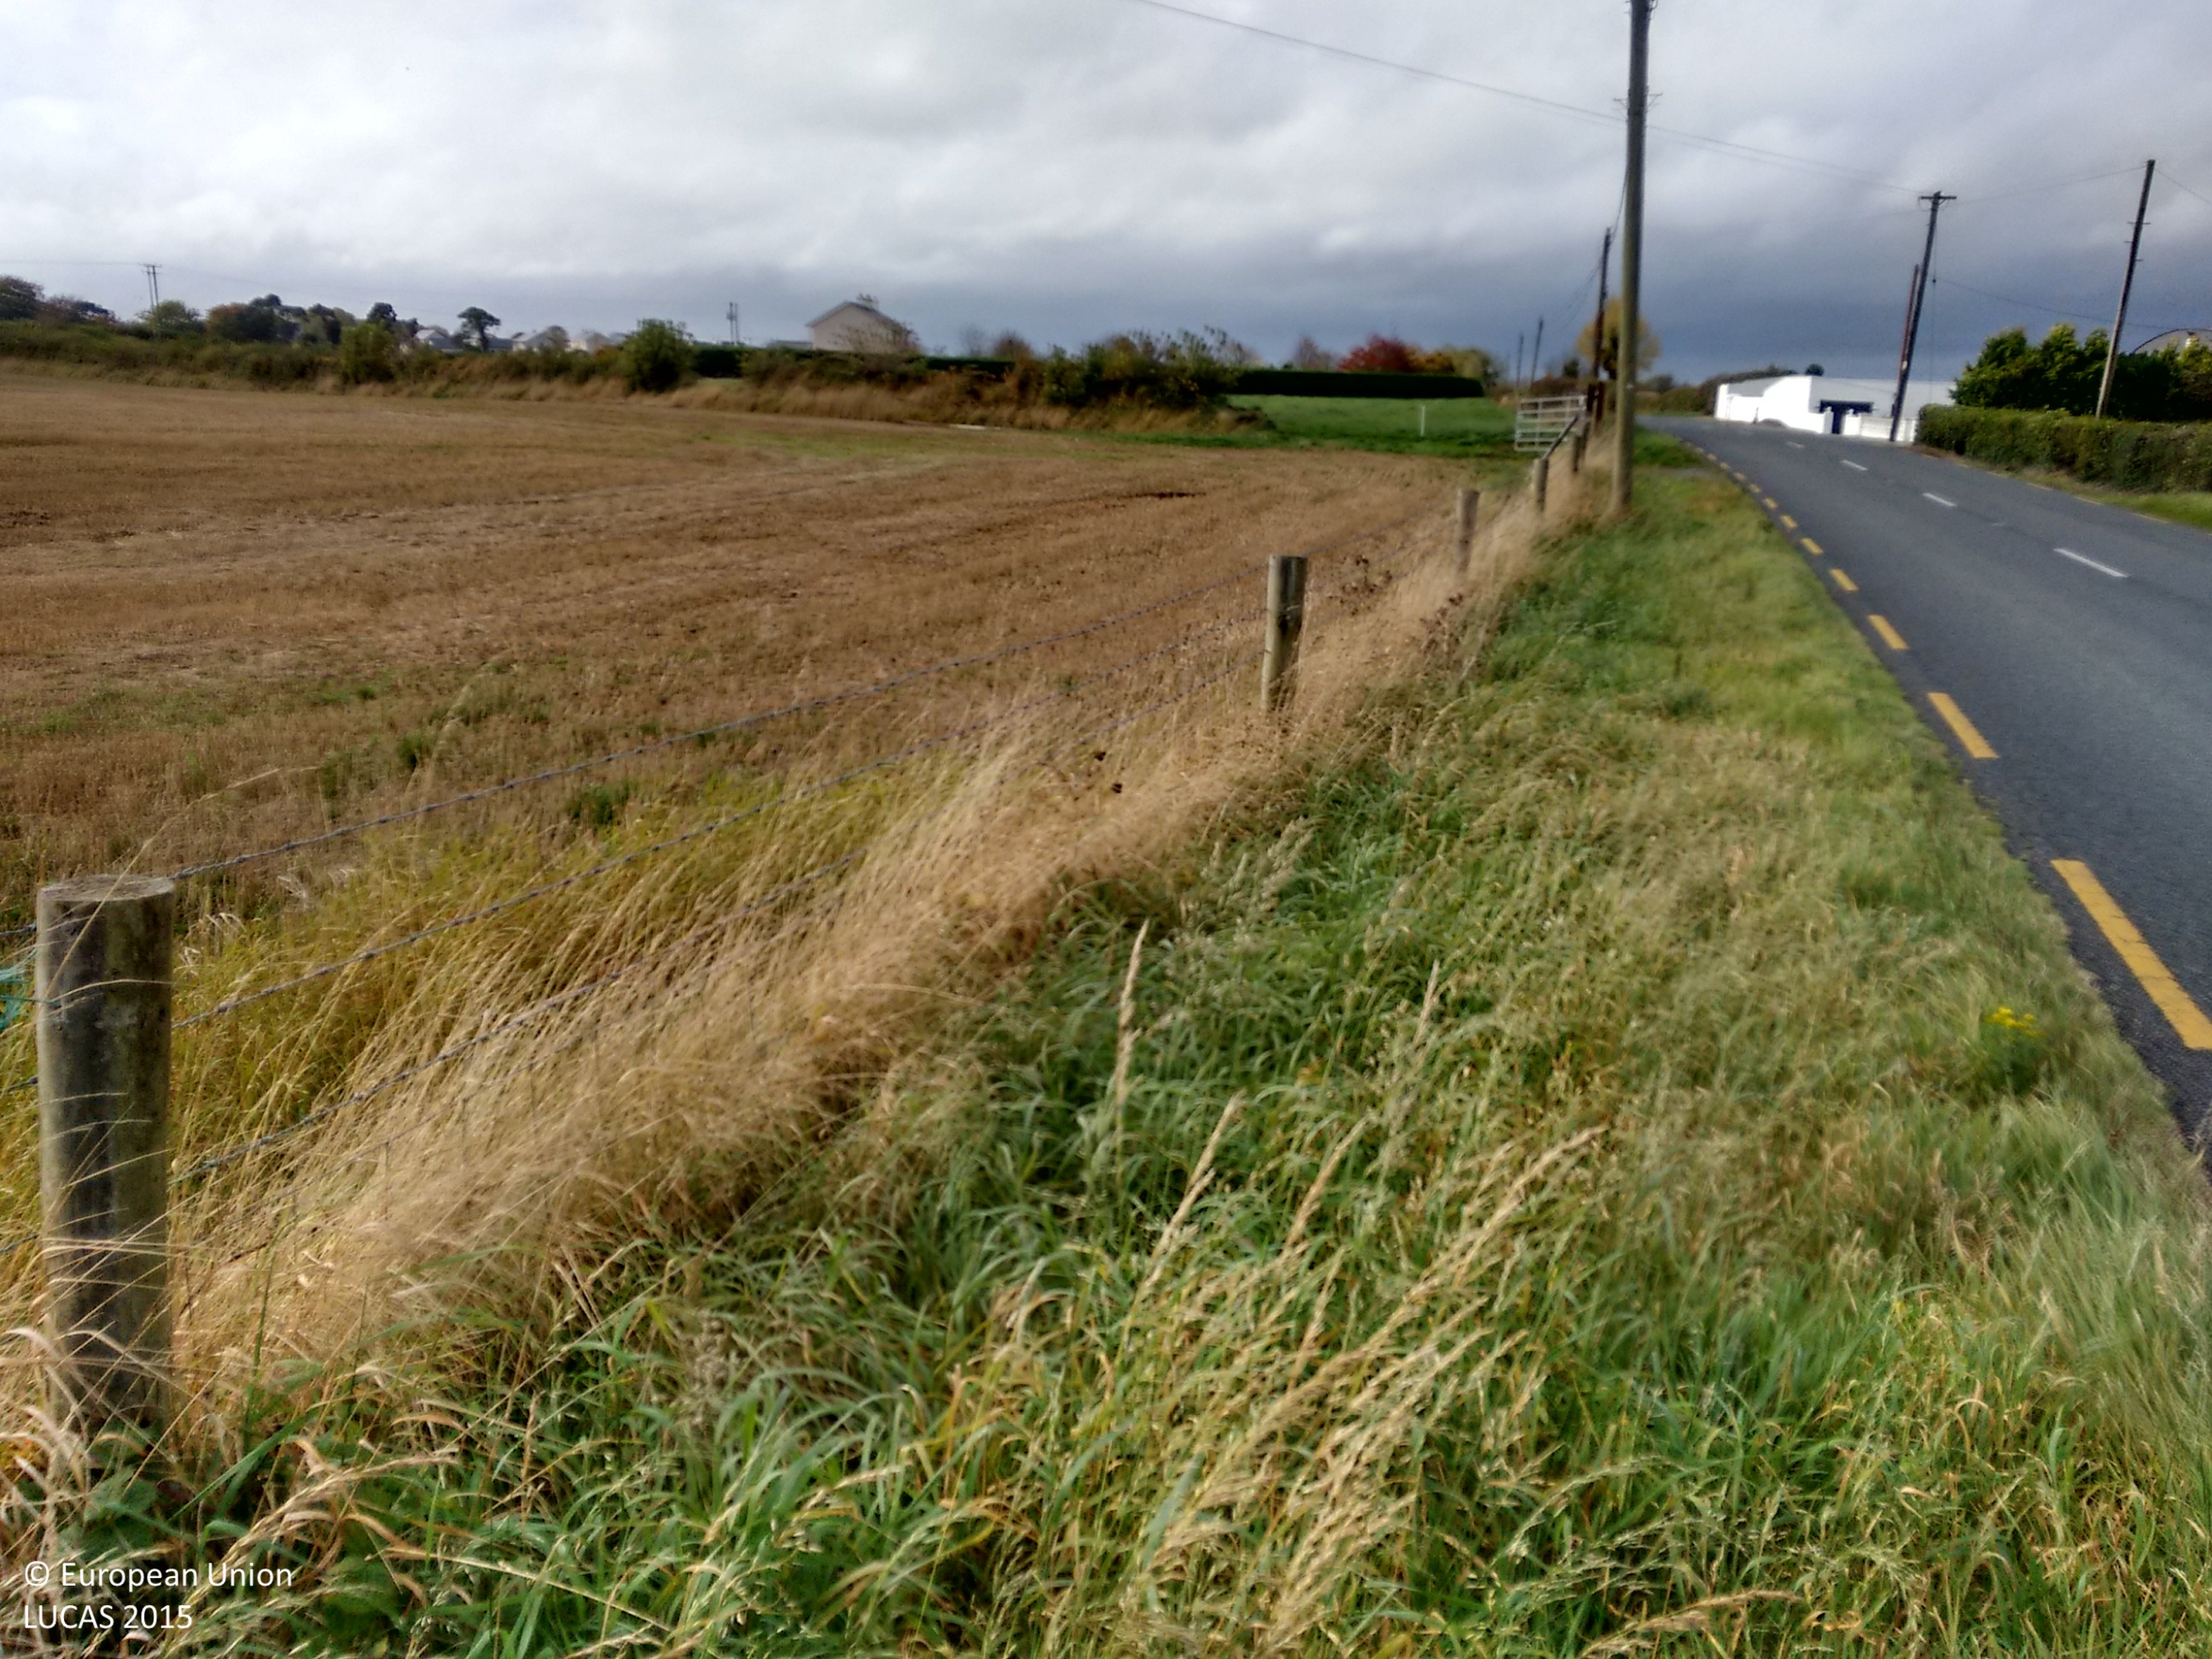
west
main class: Grassland
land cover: Grassland without tree/shrub cover
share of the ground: > 75 %
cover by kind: herbaceous plants 95 %, shrubs 5 %
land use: Agriculture (excluding fallow land and kitchen gardens)
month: October
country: IE
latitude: 53.2335
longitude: -7.6468
